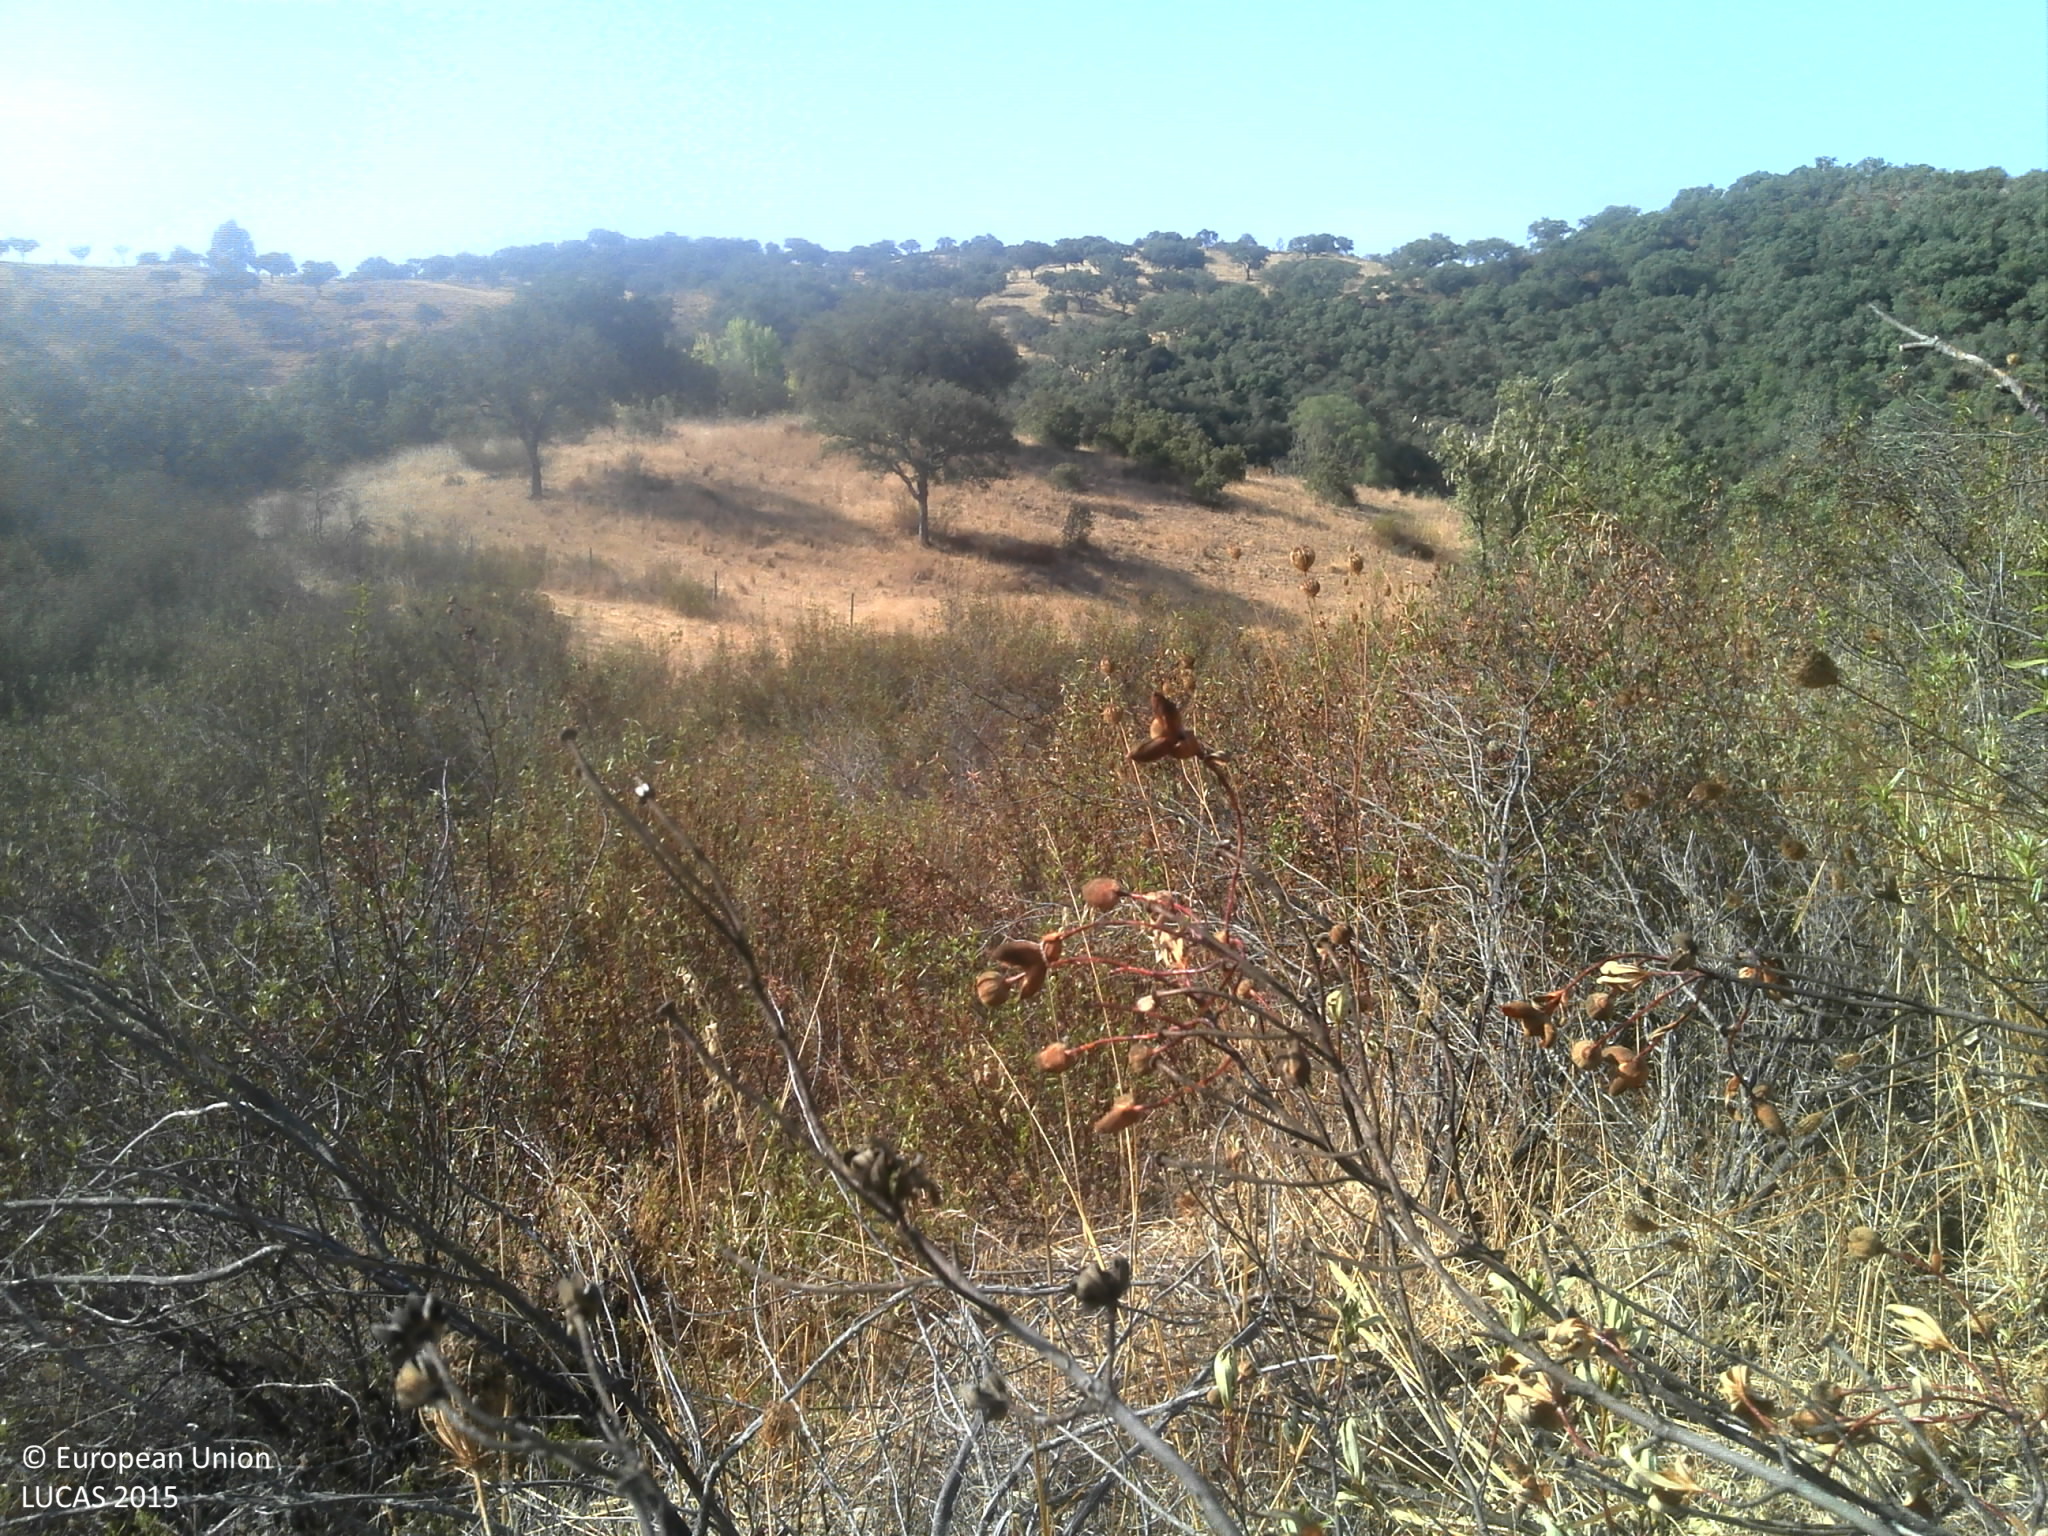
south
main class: Shrubland
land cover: Shrubland with sparse tree cover
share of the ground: 50 - 75 %
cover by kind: shrubs 65 %, herbaceous plants 20 %, unconsolidated bare surface 10 %, broadleaved forest trees 5 %
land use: Forestry
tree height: < 5 m
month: August
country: PT
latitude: 37.5598
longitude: -8.2422
